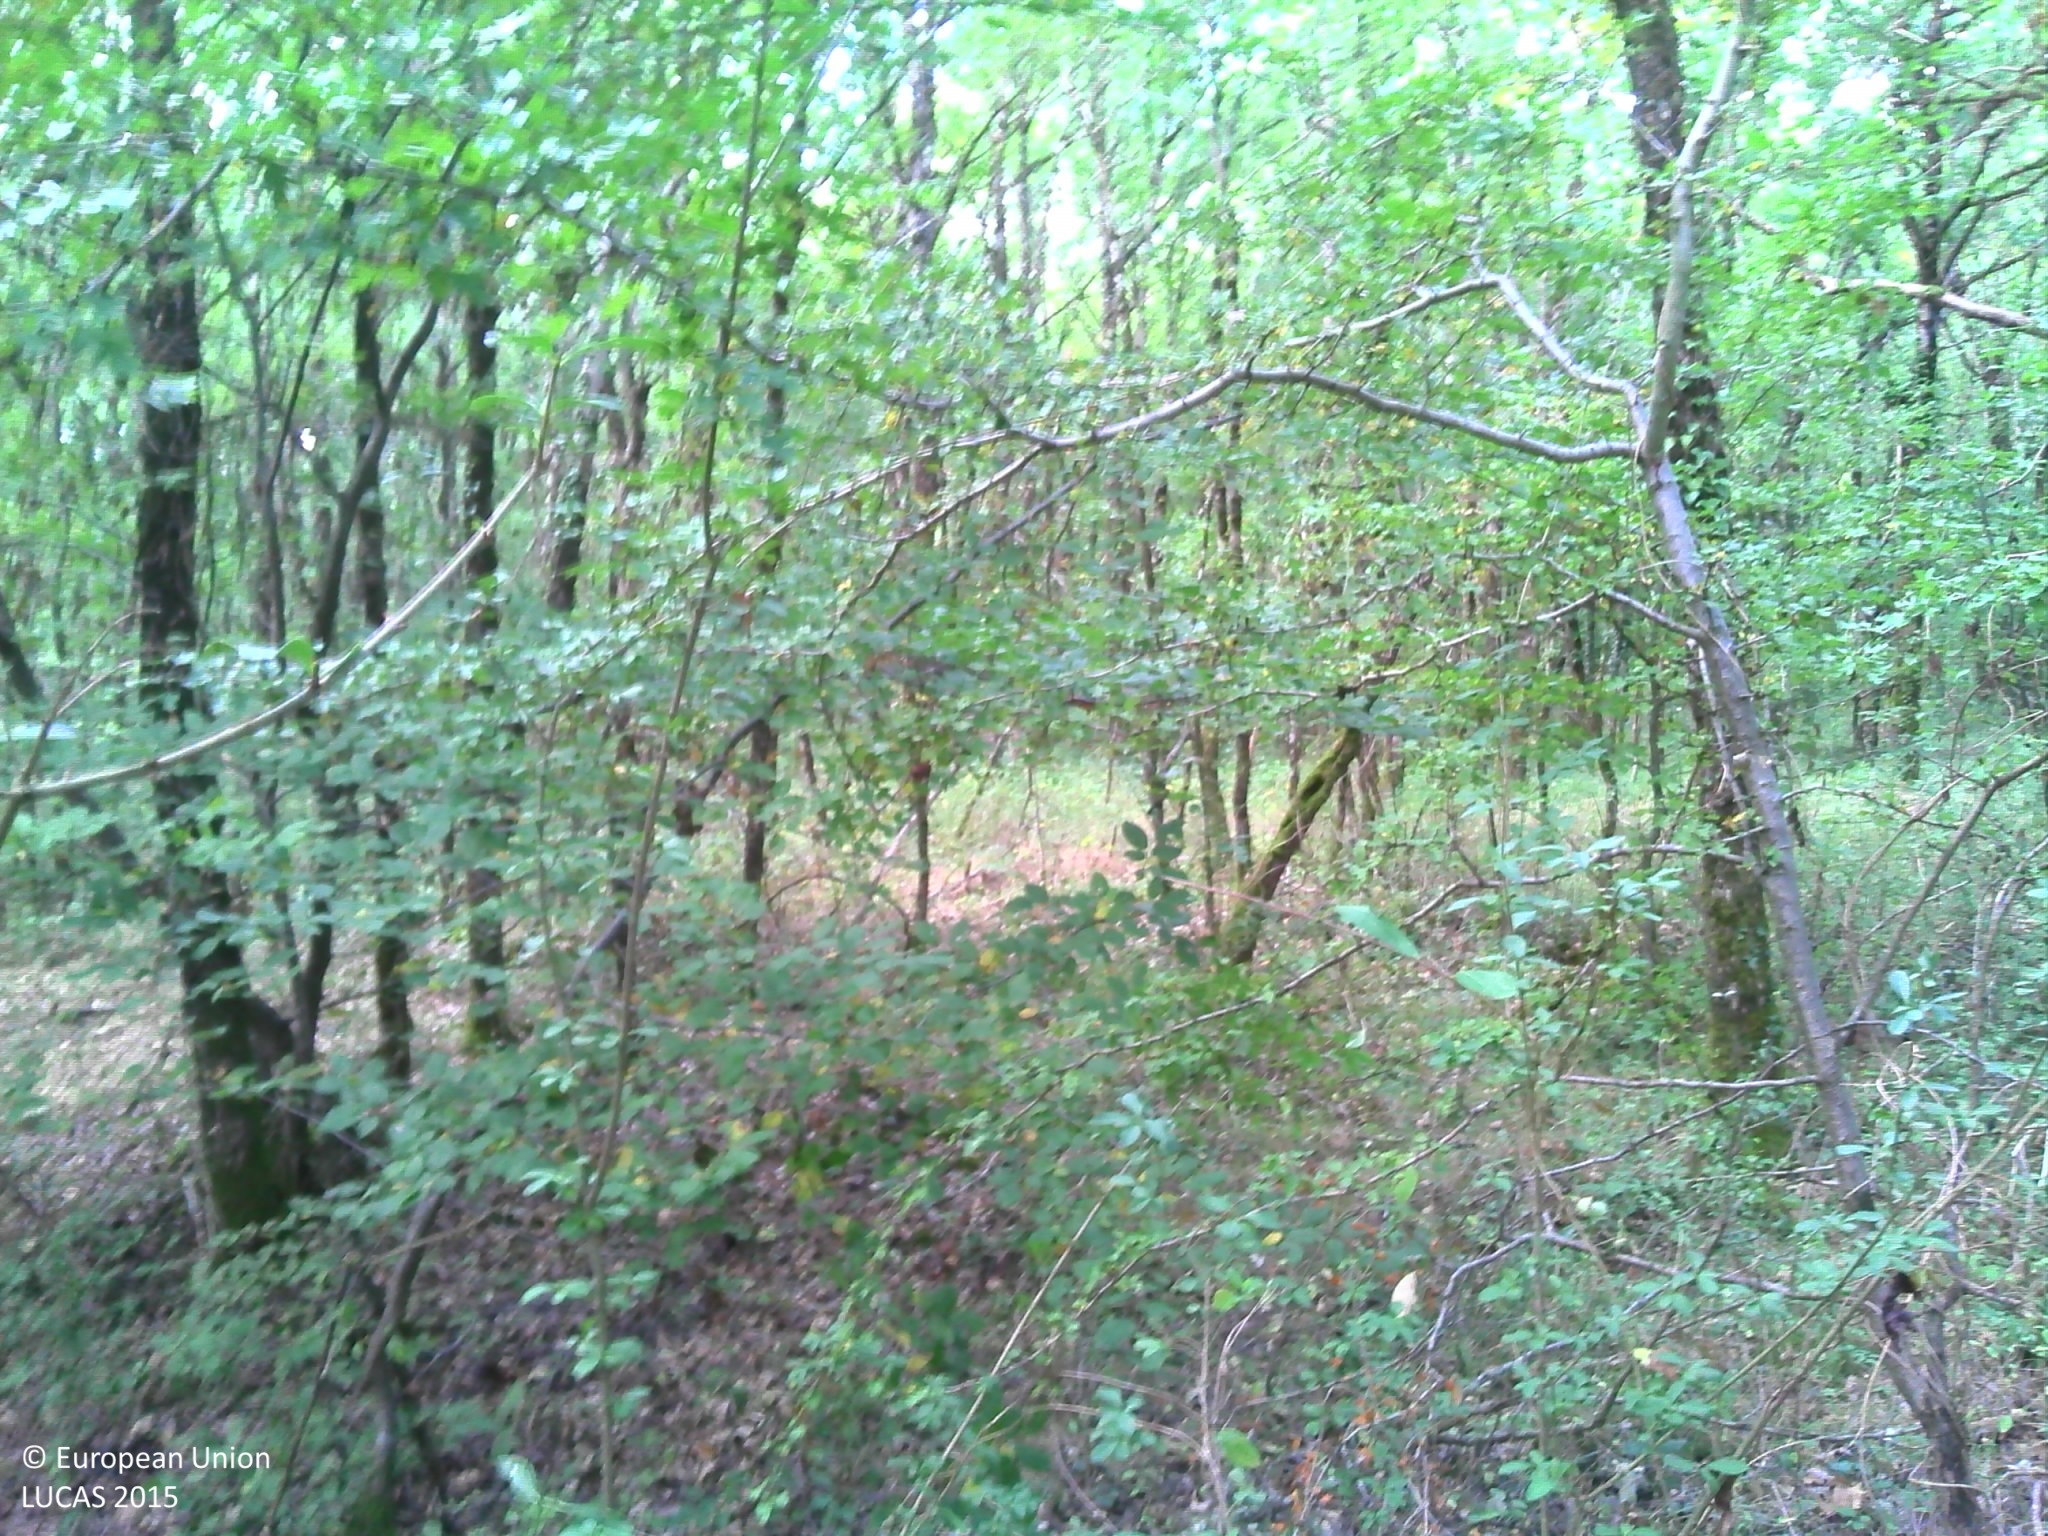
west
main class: Woodland
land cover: Broadleaved woodland
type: mesophytic deciduous forest
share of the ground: > 75 %
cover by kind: broadleaved forest trees 85 %, shrubs 10 %, herbaceous plants 5 %
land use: Forestry
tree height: > 5 m
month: July
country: FR
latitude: 46.7520
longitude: 1.4664
